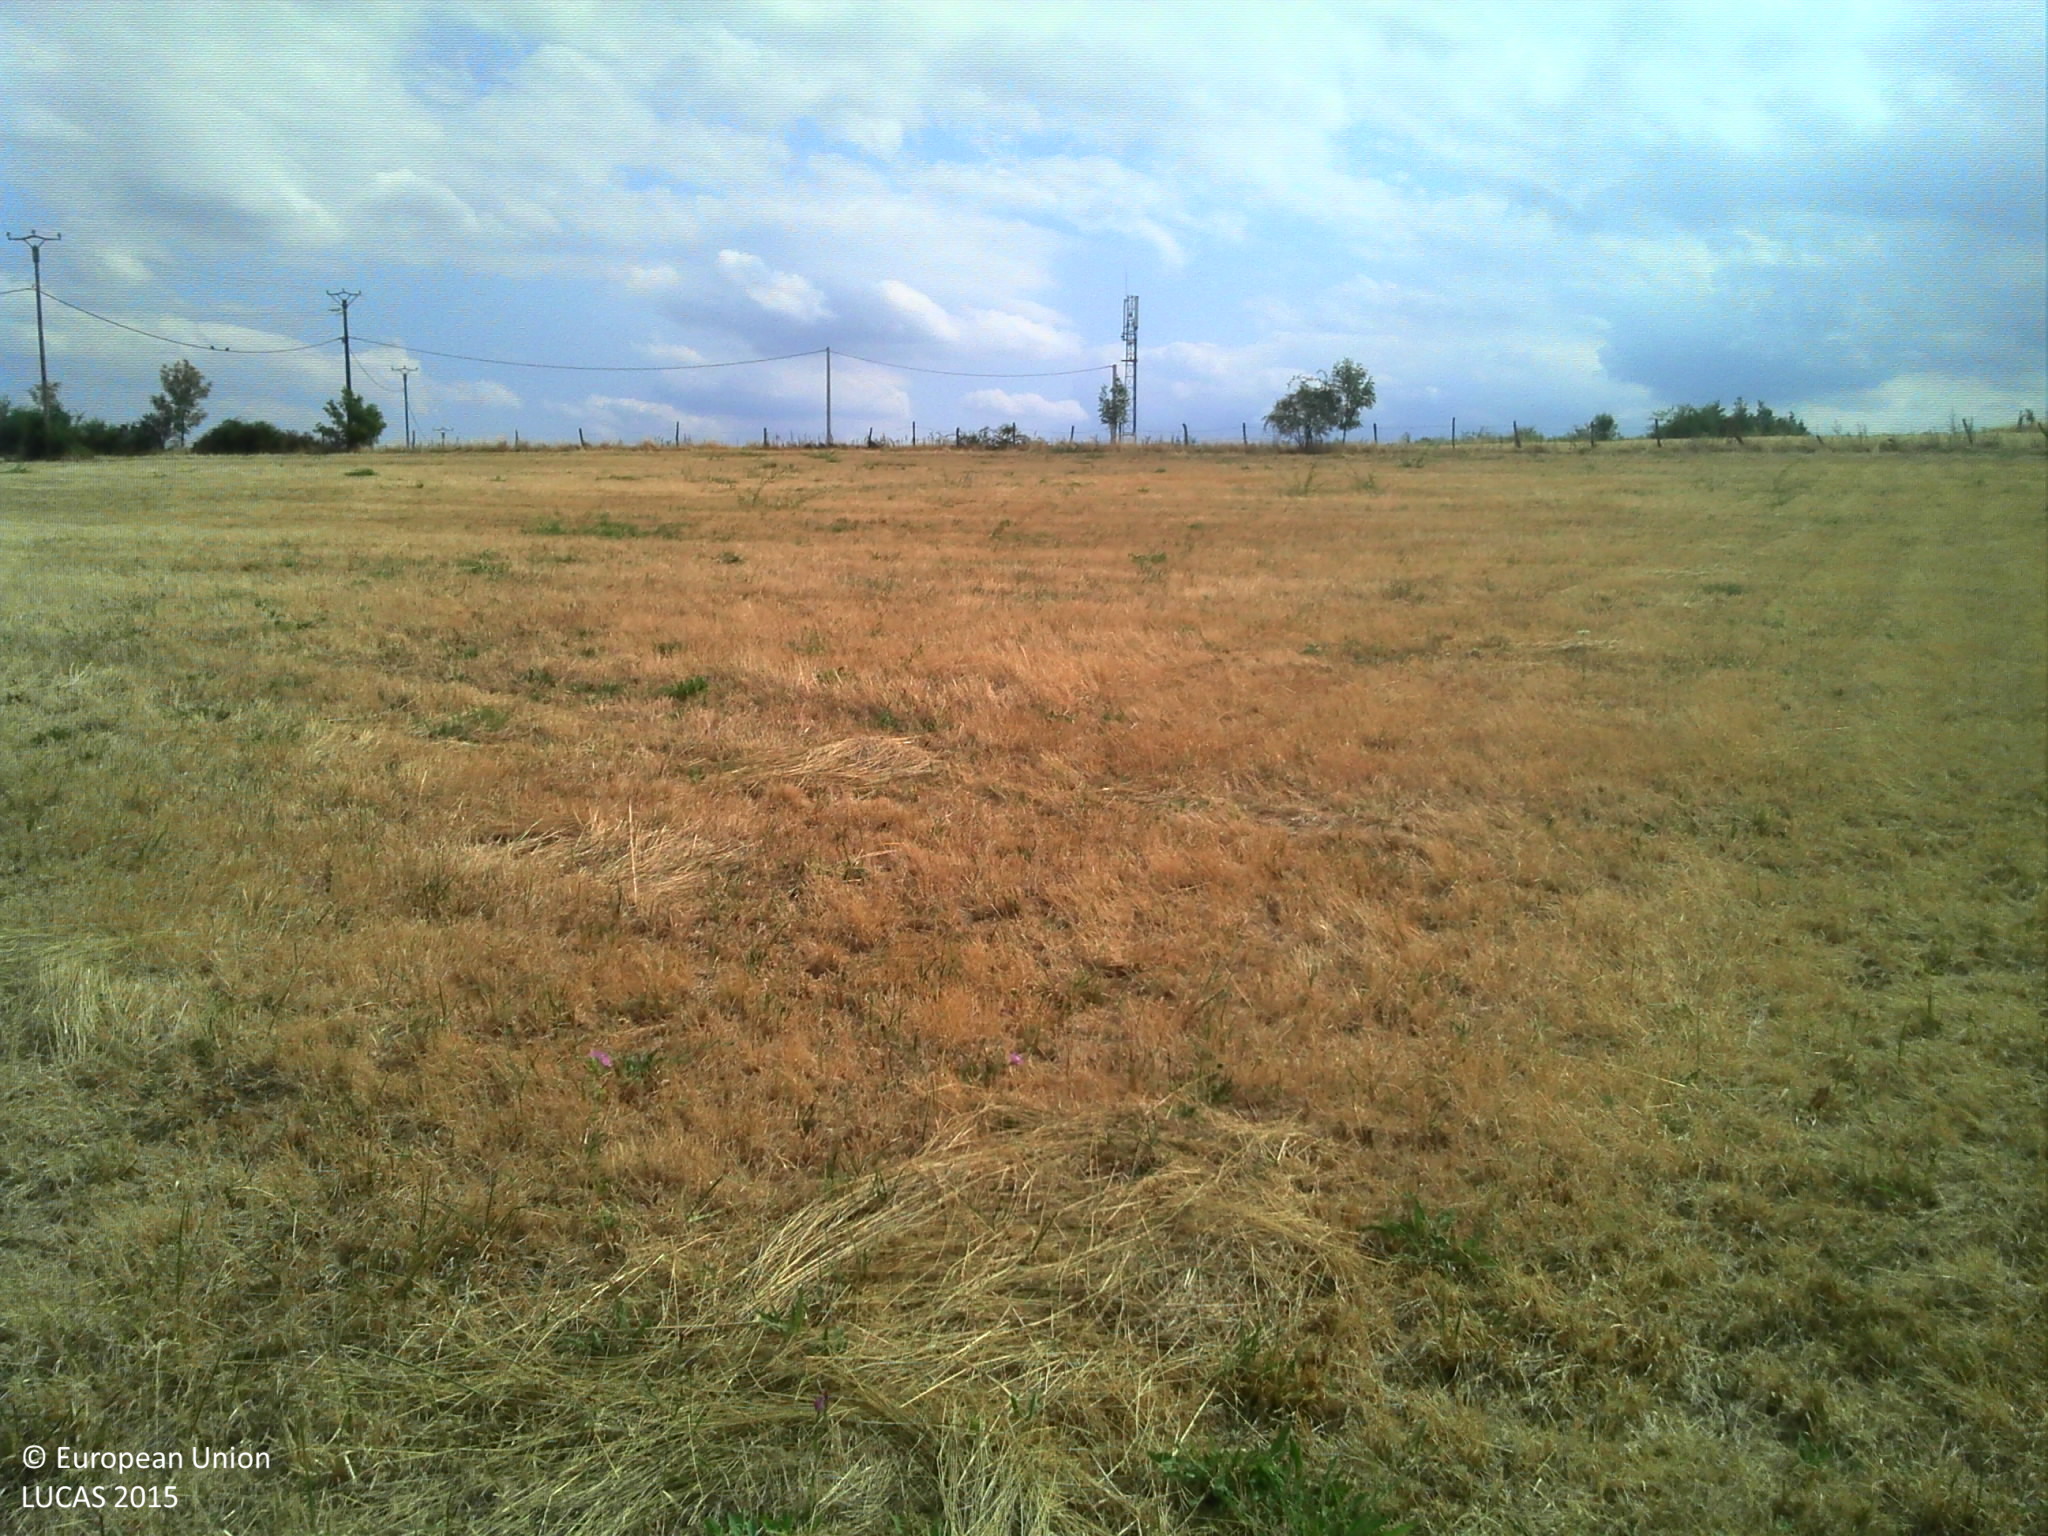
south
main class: Grassland
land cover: Grassland without tree/shrub cover
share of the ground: > 75 %
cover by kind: herbaceous plants 100 %
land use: Agriculture (excluding fallow land and kitchen gardens)
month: August
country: FR
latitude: 45.6604
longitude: 4.7031
